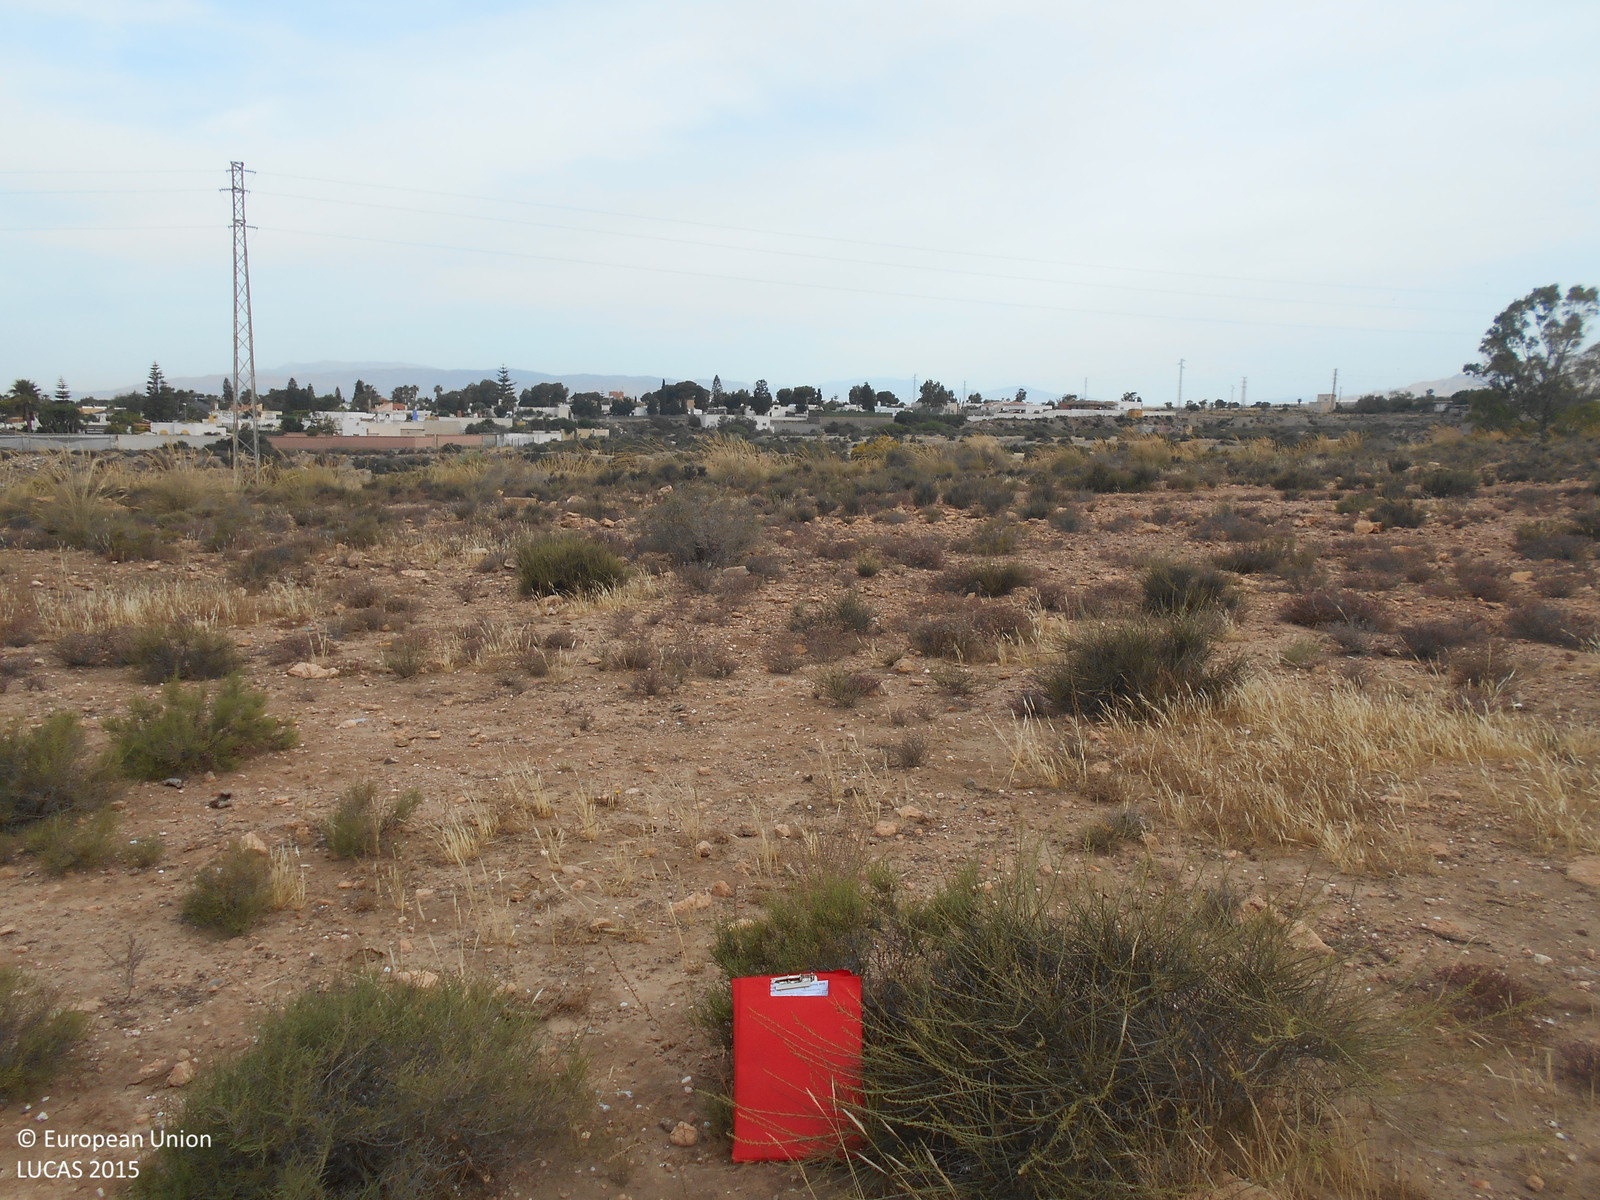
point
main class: Shrubland
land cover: Shrubland without tree cover
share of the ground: 10 - 25 %
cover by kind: unconsolidated bare surface 70 %, shrubs 20 %, herbaceous plants 10 %
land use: Semi-natural and natural areas not in use
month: May
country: ES
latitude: 36.8541
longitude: -2.3004
